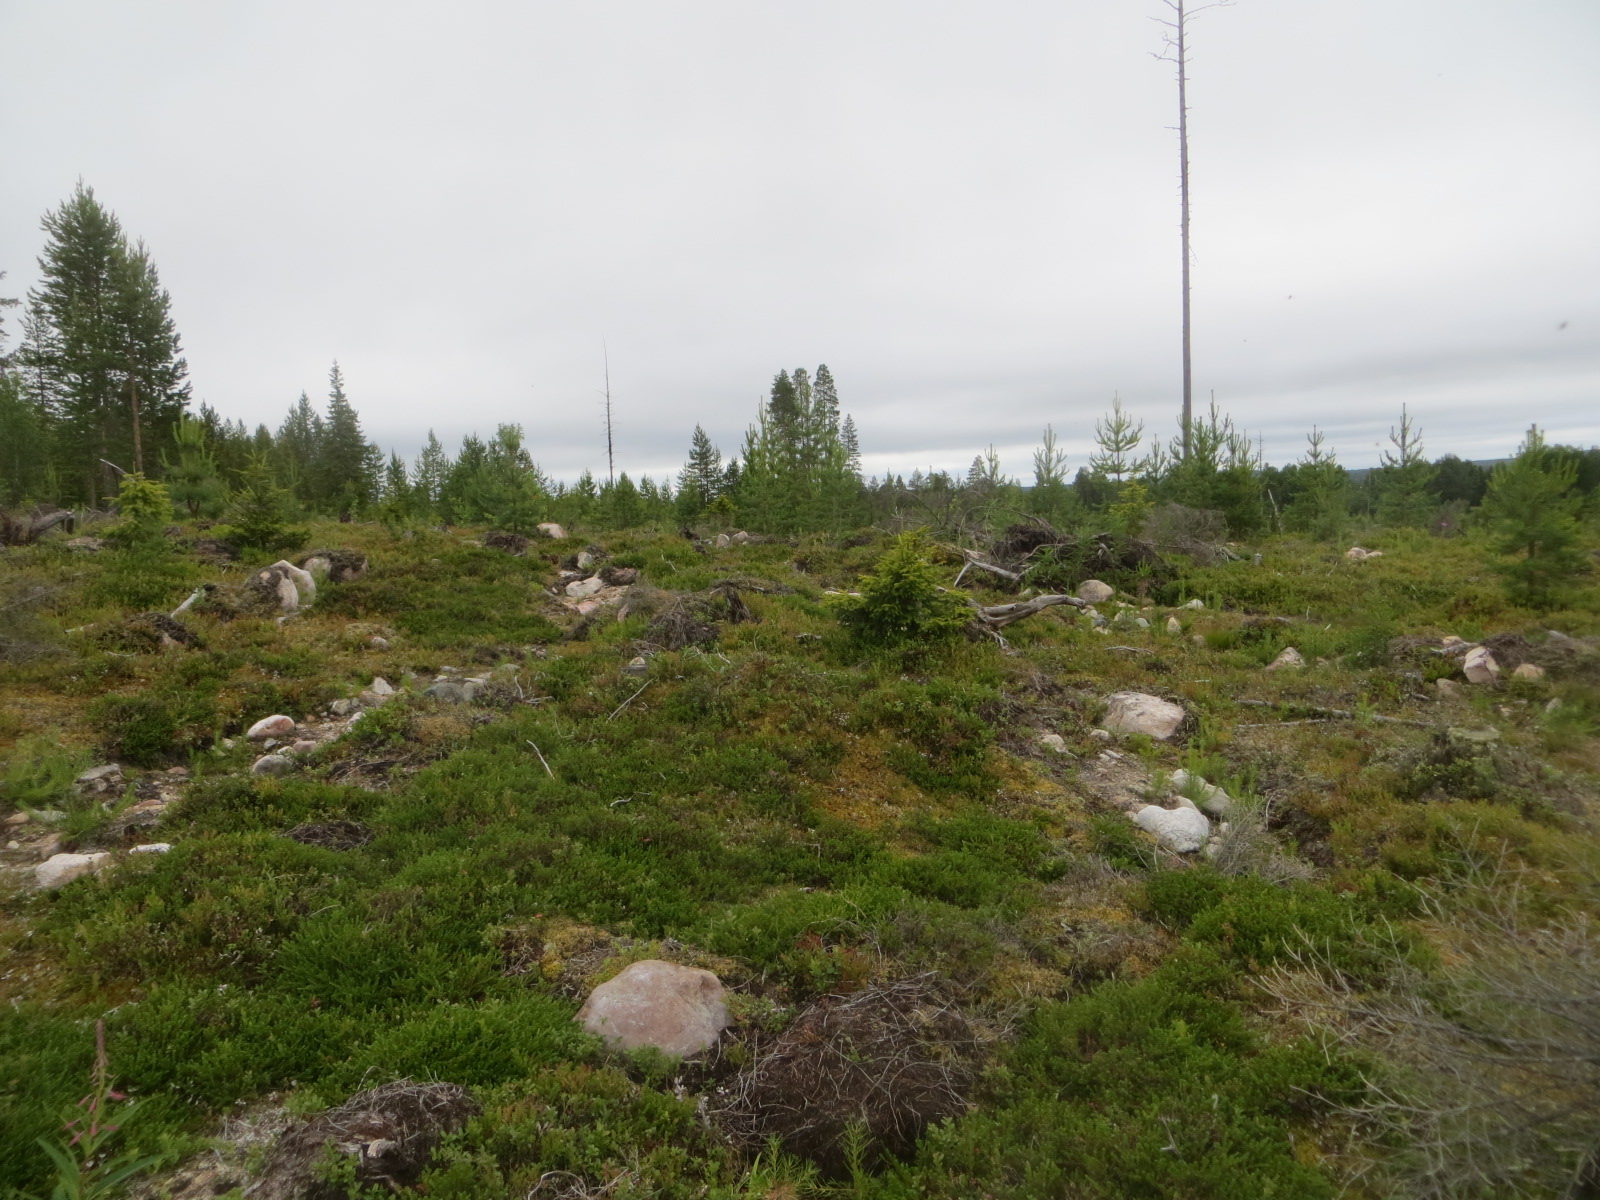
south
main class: Woodland
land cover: Pine dominated coniferous woodland
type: boreal forest
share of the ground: 25 - 50 %
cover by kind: shrubs 70 %, coniferous forest trees 25 %, broadleaved forest trees 5 %
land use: Forestry
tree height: < 5 m
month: July
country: FI
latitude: 66.4296
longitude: 24.4093
